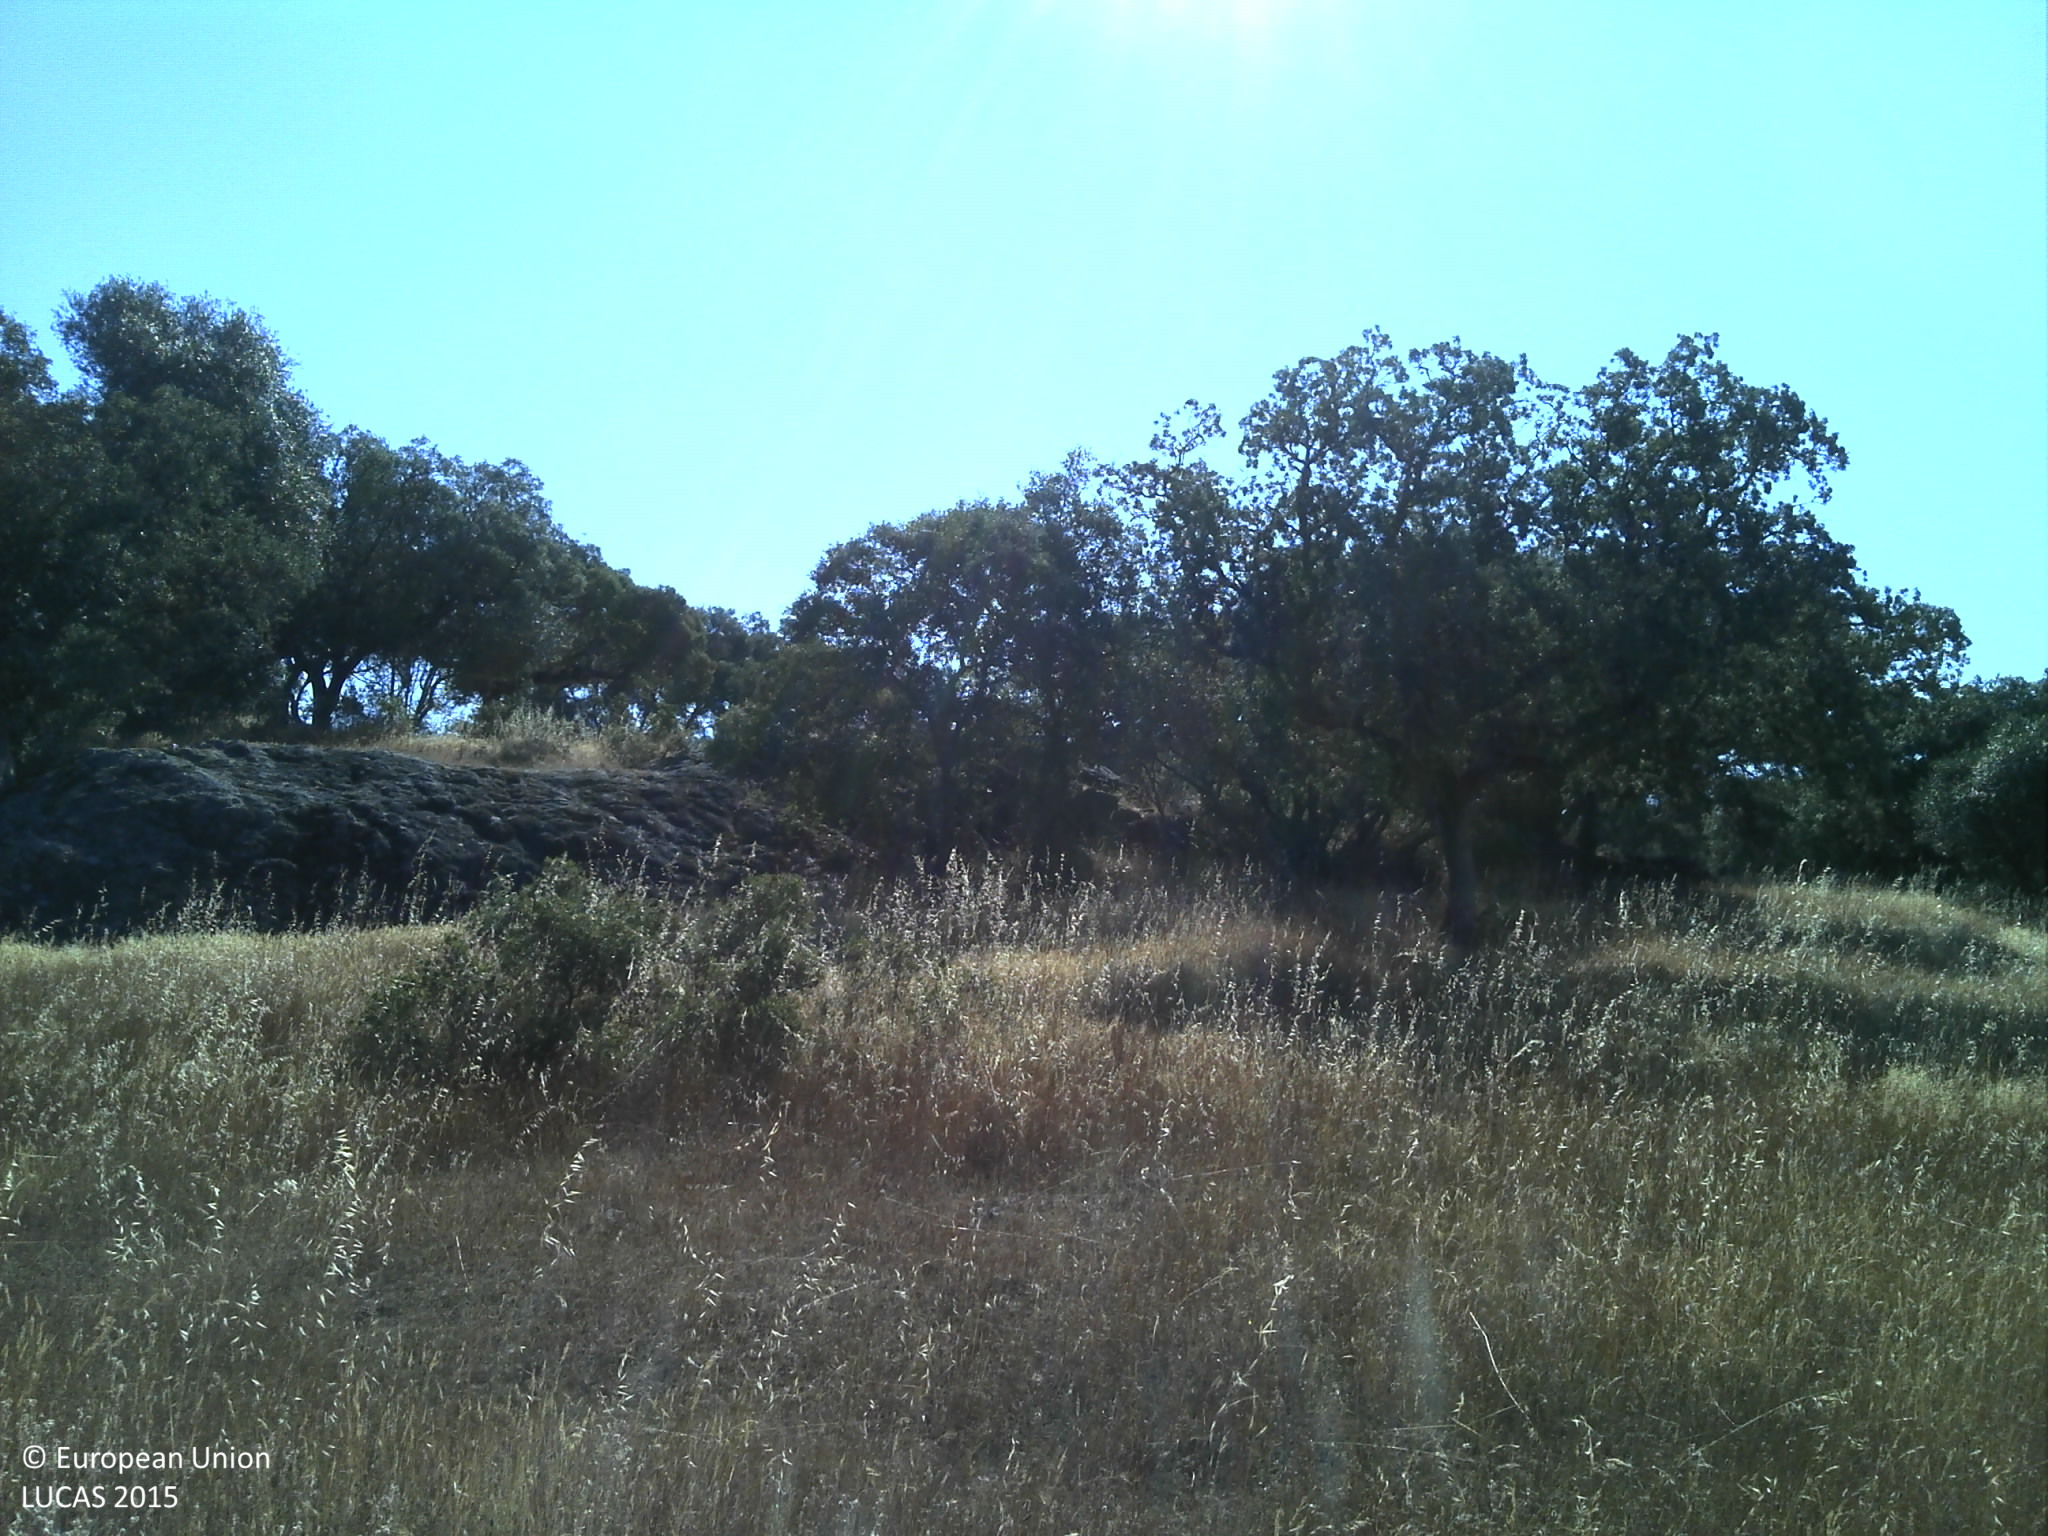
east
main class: Woodland
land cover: Broadleaved woodland
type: broadleaved evergreen forest
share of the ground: 10 - 25 %
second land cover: Grassland without tree/shrub cover
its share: 25 - 50 %
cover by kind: unconsolidated bare surface 55 %, herbaceous plants 30 %, broadleaved forest trees 15 %
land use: Forestry
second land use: Agriculture (excluding fallow land and kitchen gardens)
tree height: > 5 m
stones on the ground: < 10 %
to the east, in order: Broadleaved woodland; Grassland without tree/shrub cover; Broadleaved woodland; Tracks; Grass margins; Fences; Broadleaved woodland
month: June
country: PT
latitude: 38.4411
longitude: -8.0862
